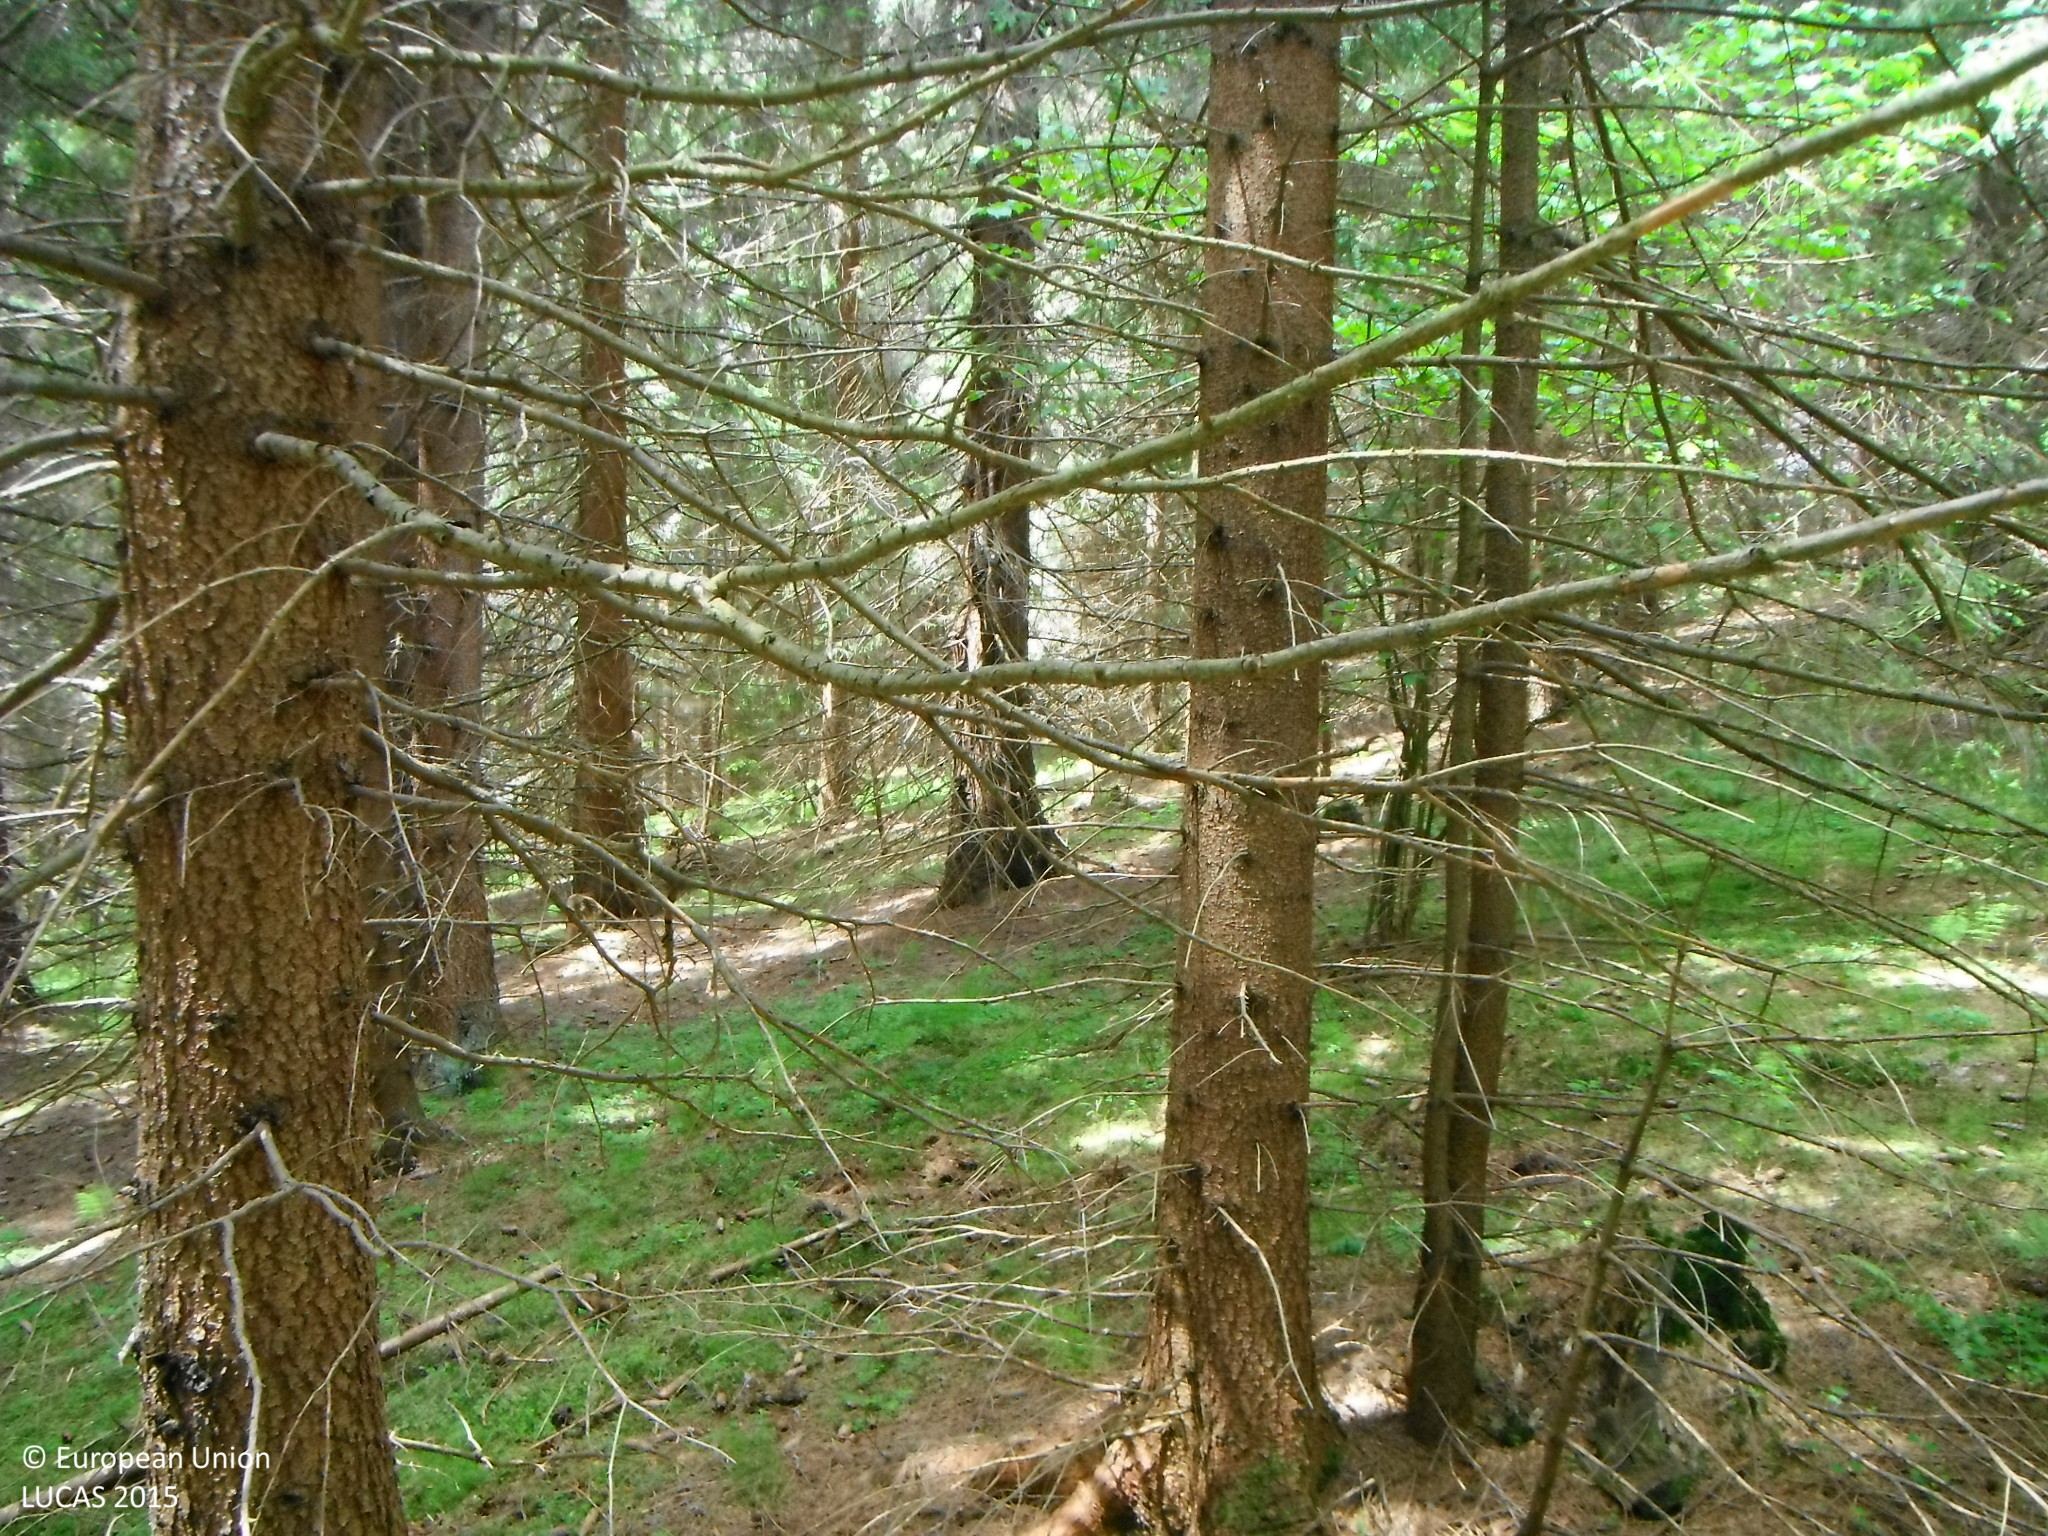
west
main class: Woodland
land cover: Spruce dominated coniferous woodland
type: alpine coniferous forest
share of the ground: > 75 %
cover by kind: coniferous forest trees 100 %
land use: Forestry
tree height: > 5 m
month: June
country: SK
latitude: 49.1908
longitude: 19.4801
